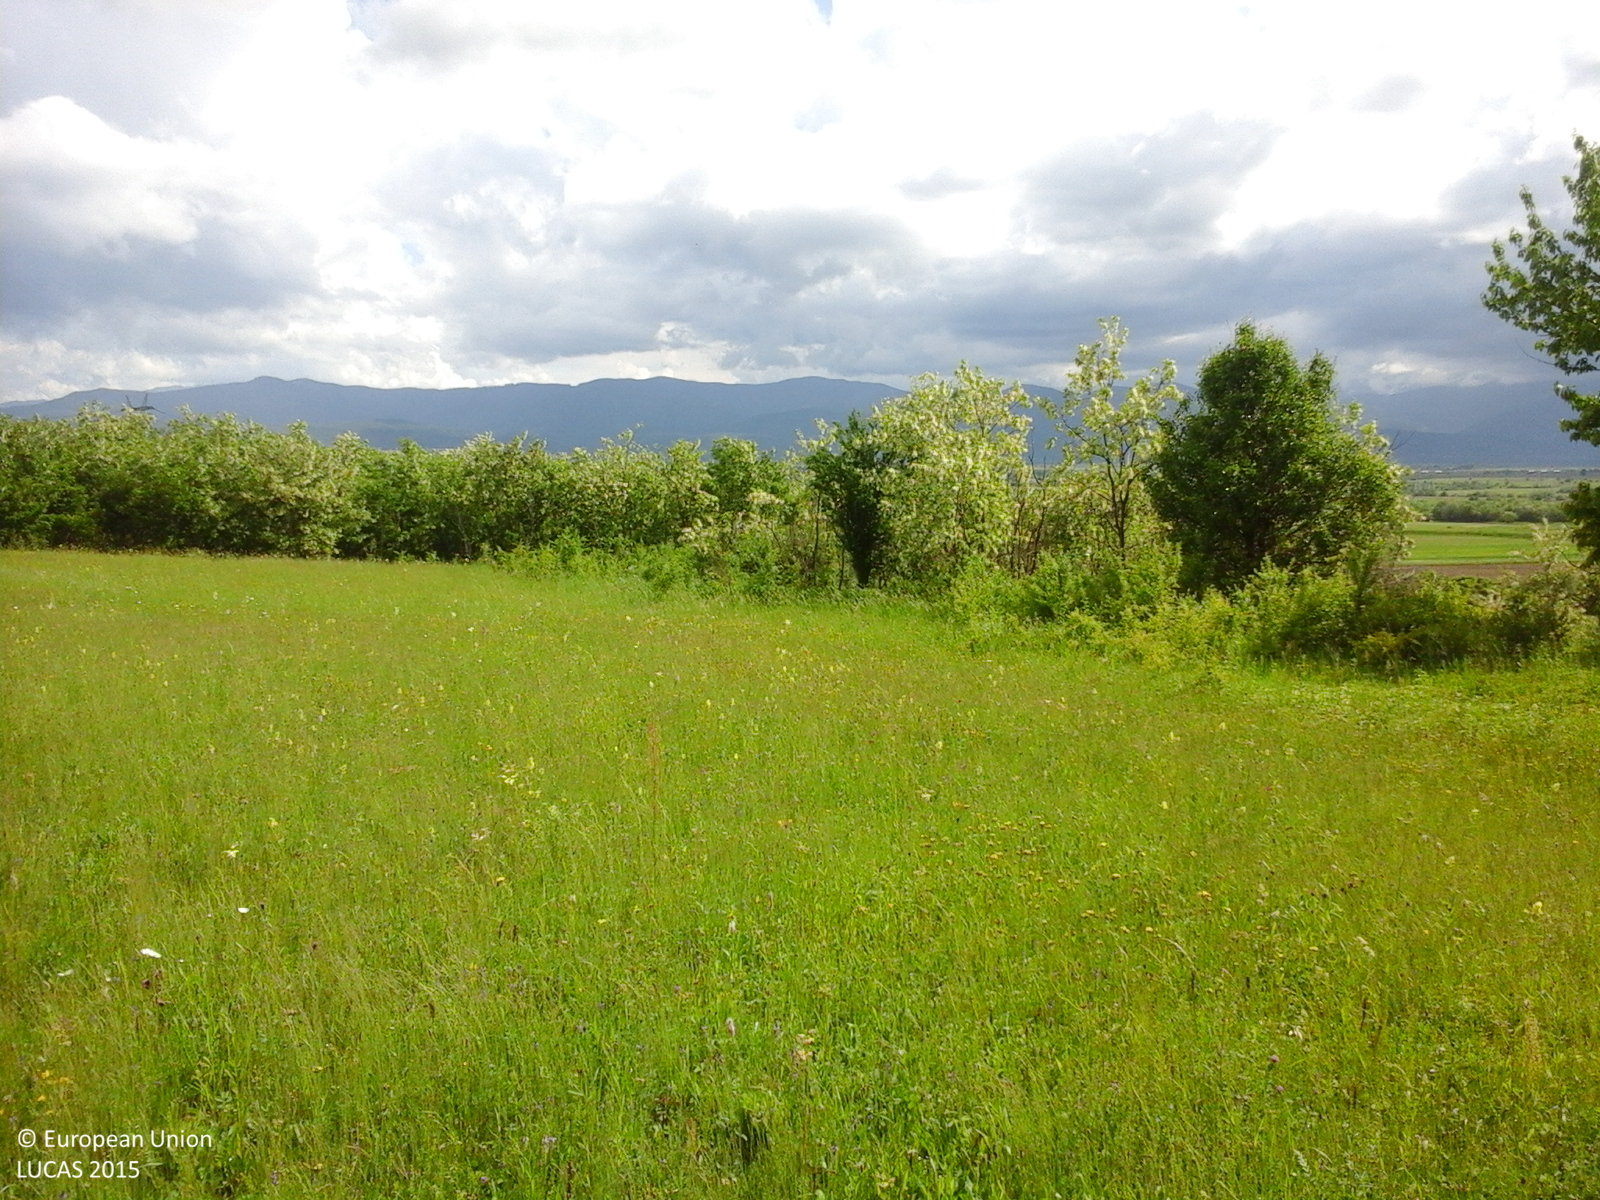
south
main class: Cropland
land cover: Other leguminous and mixtures for fodder
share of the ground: > 75 %
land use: Agriculture (excluding fallow land and kitchen gardens)
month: May
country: RO
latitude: 45.7939
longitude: 25.1603
